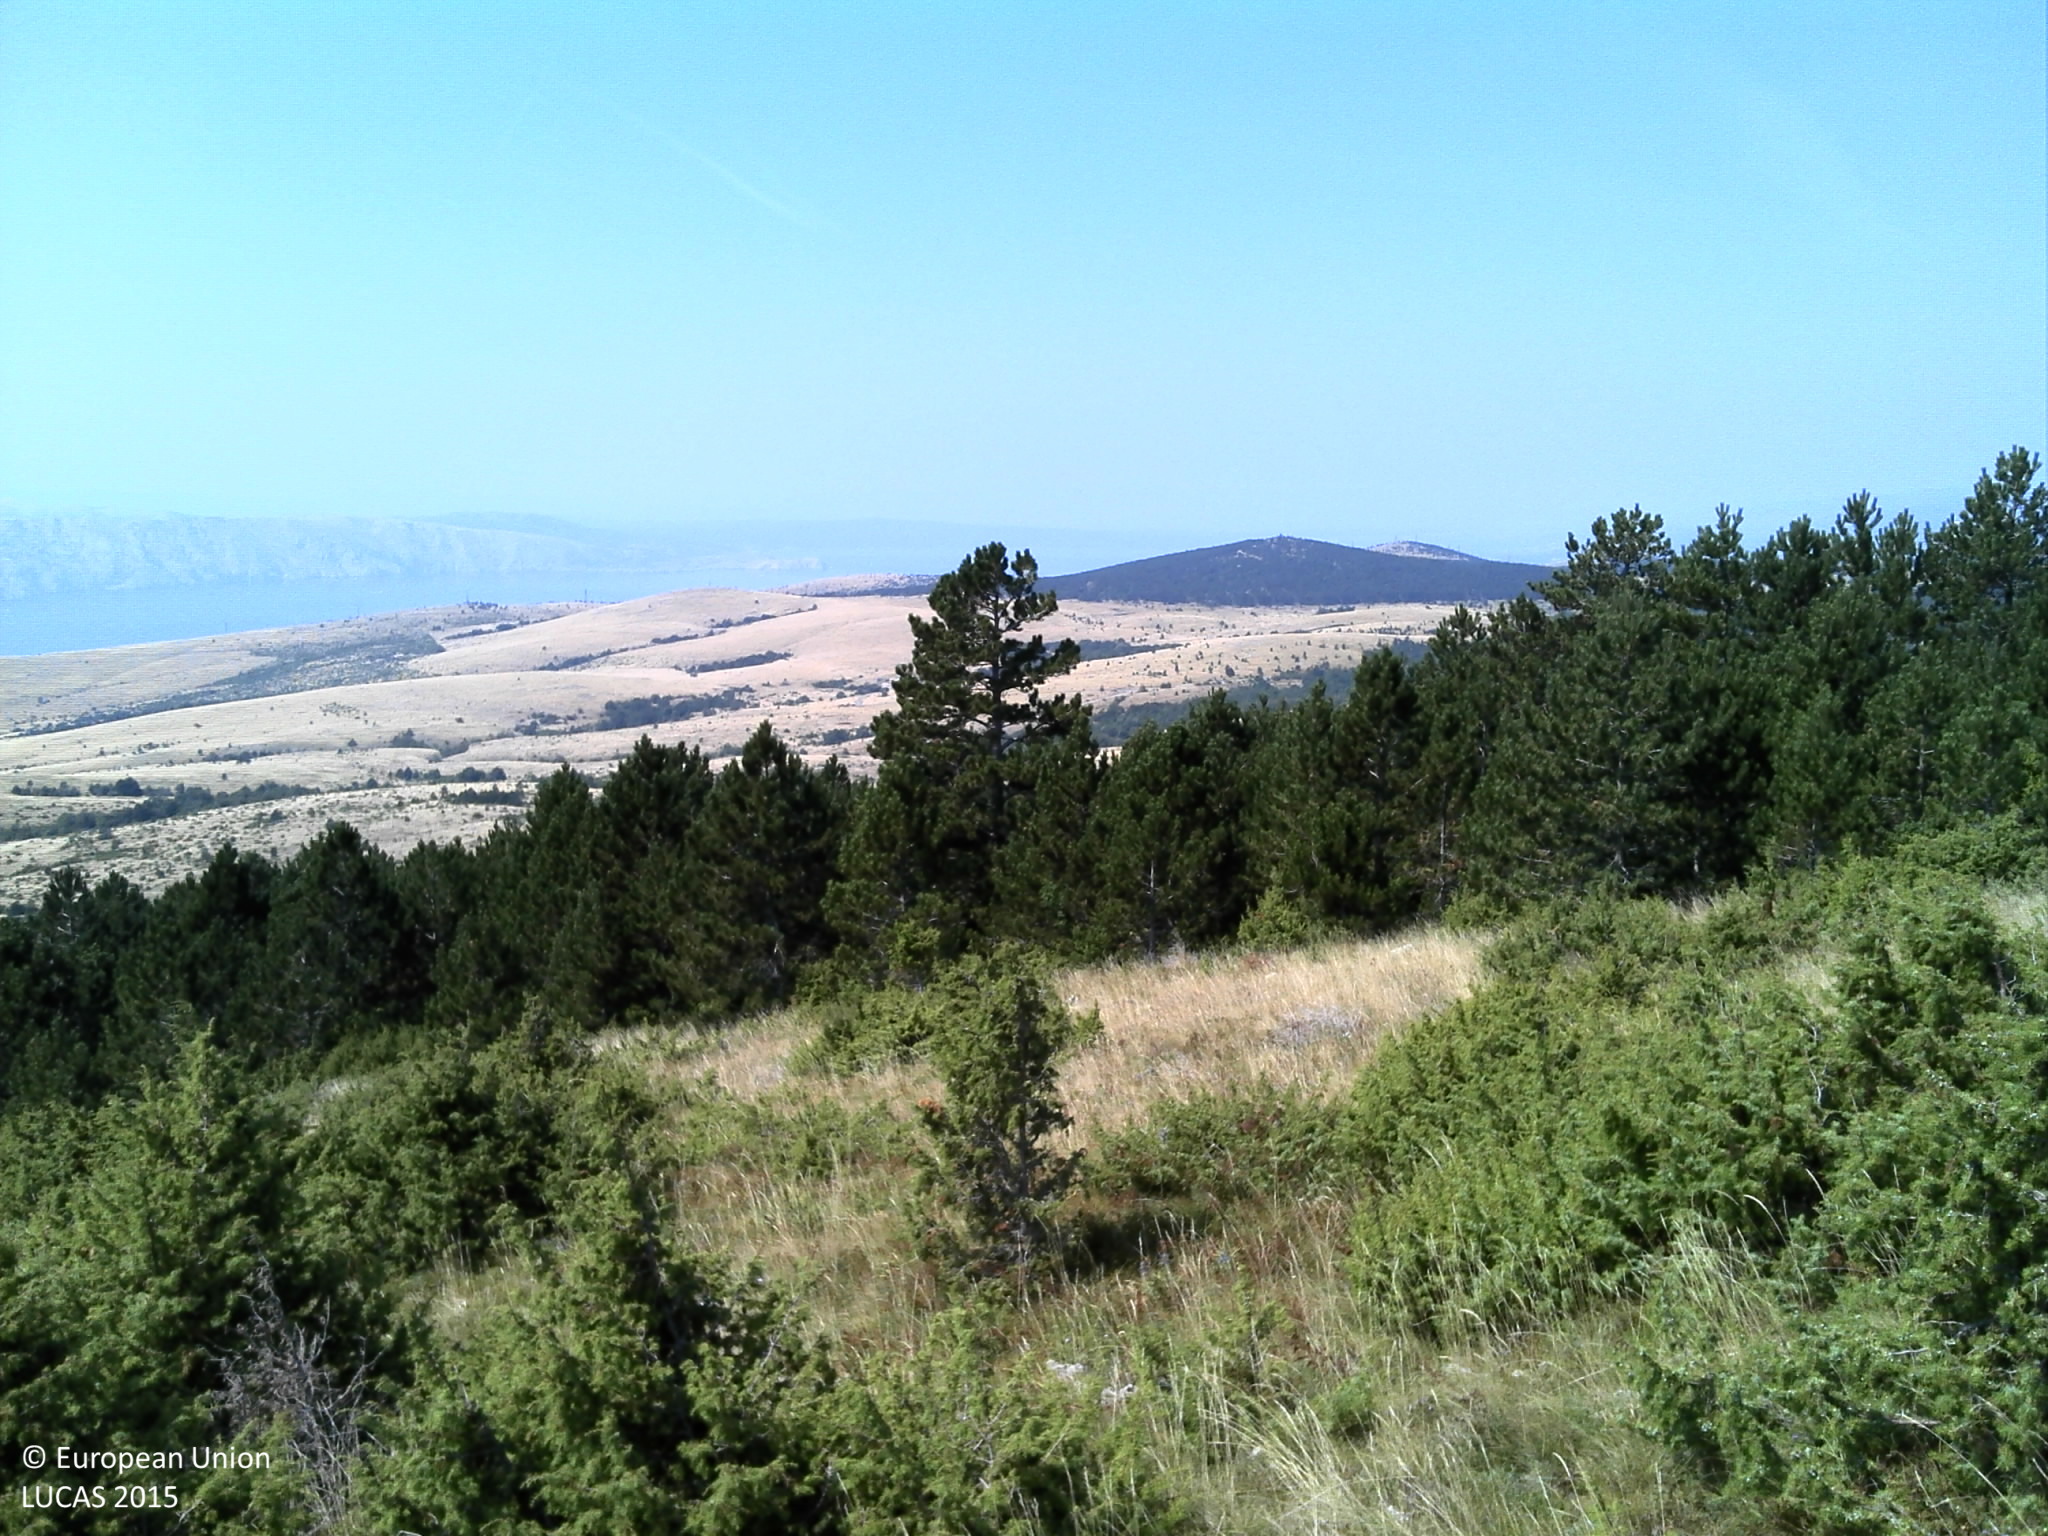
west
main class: Shrubland
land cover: Shrubland with sparse tree cover
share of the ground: > 75 %
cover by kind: shrubs 65 %, herbaceous plants 20 %, coniferous forest trees 5 %, consolidated bare surface 5 %, unconsolidated bare surface 5 %
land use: Semi-natural and natural areas not in use
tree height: < 5 m
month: August
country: HR
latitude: 45.0089
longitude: 14.9553
